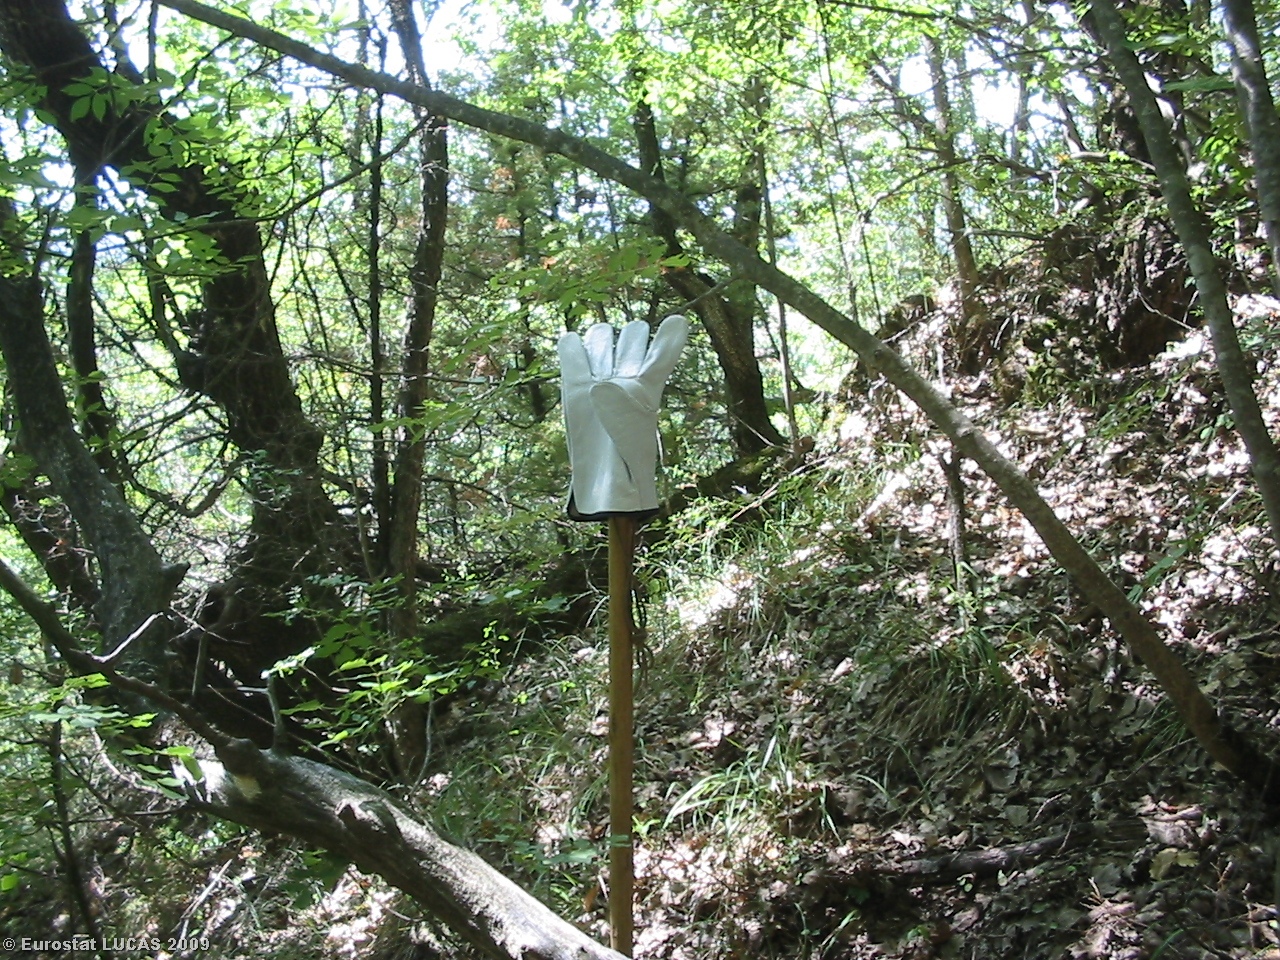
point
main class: Woodland
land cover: Broadleaved woodland
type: thermophilous deciduous forest
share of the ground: > 75 %
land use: Forestry
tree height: > 5 m
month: August
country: IT
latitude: 44.4405
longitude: 10.2382
